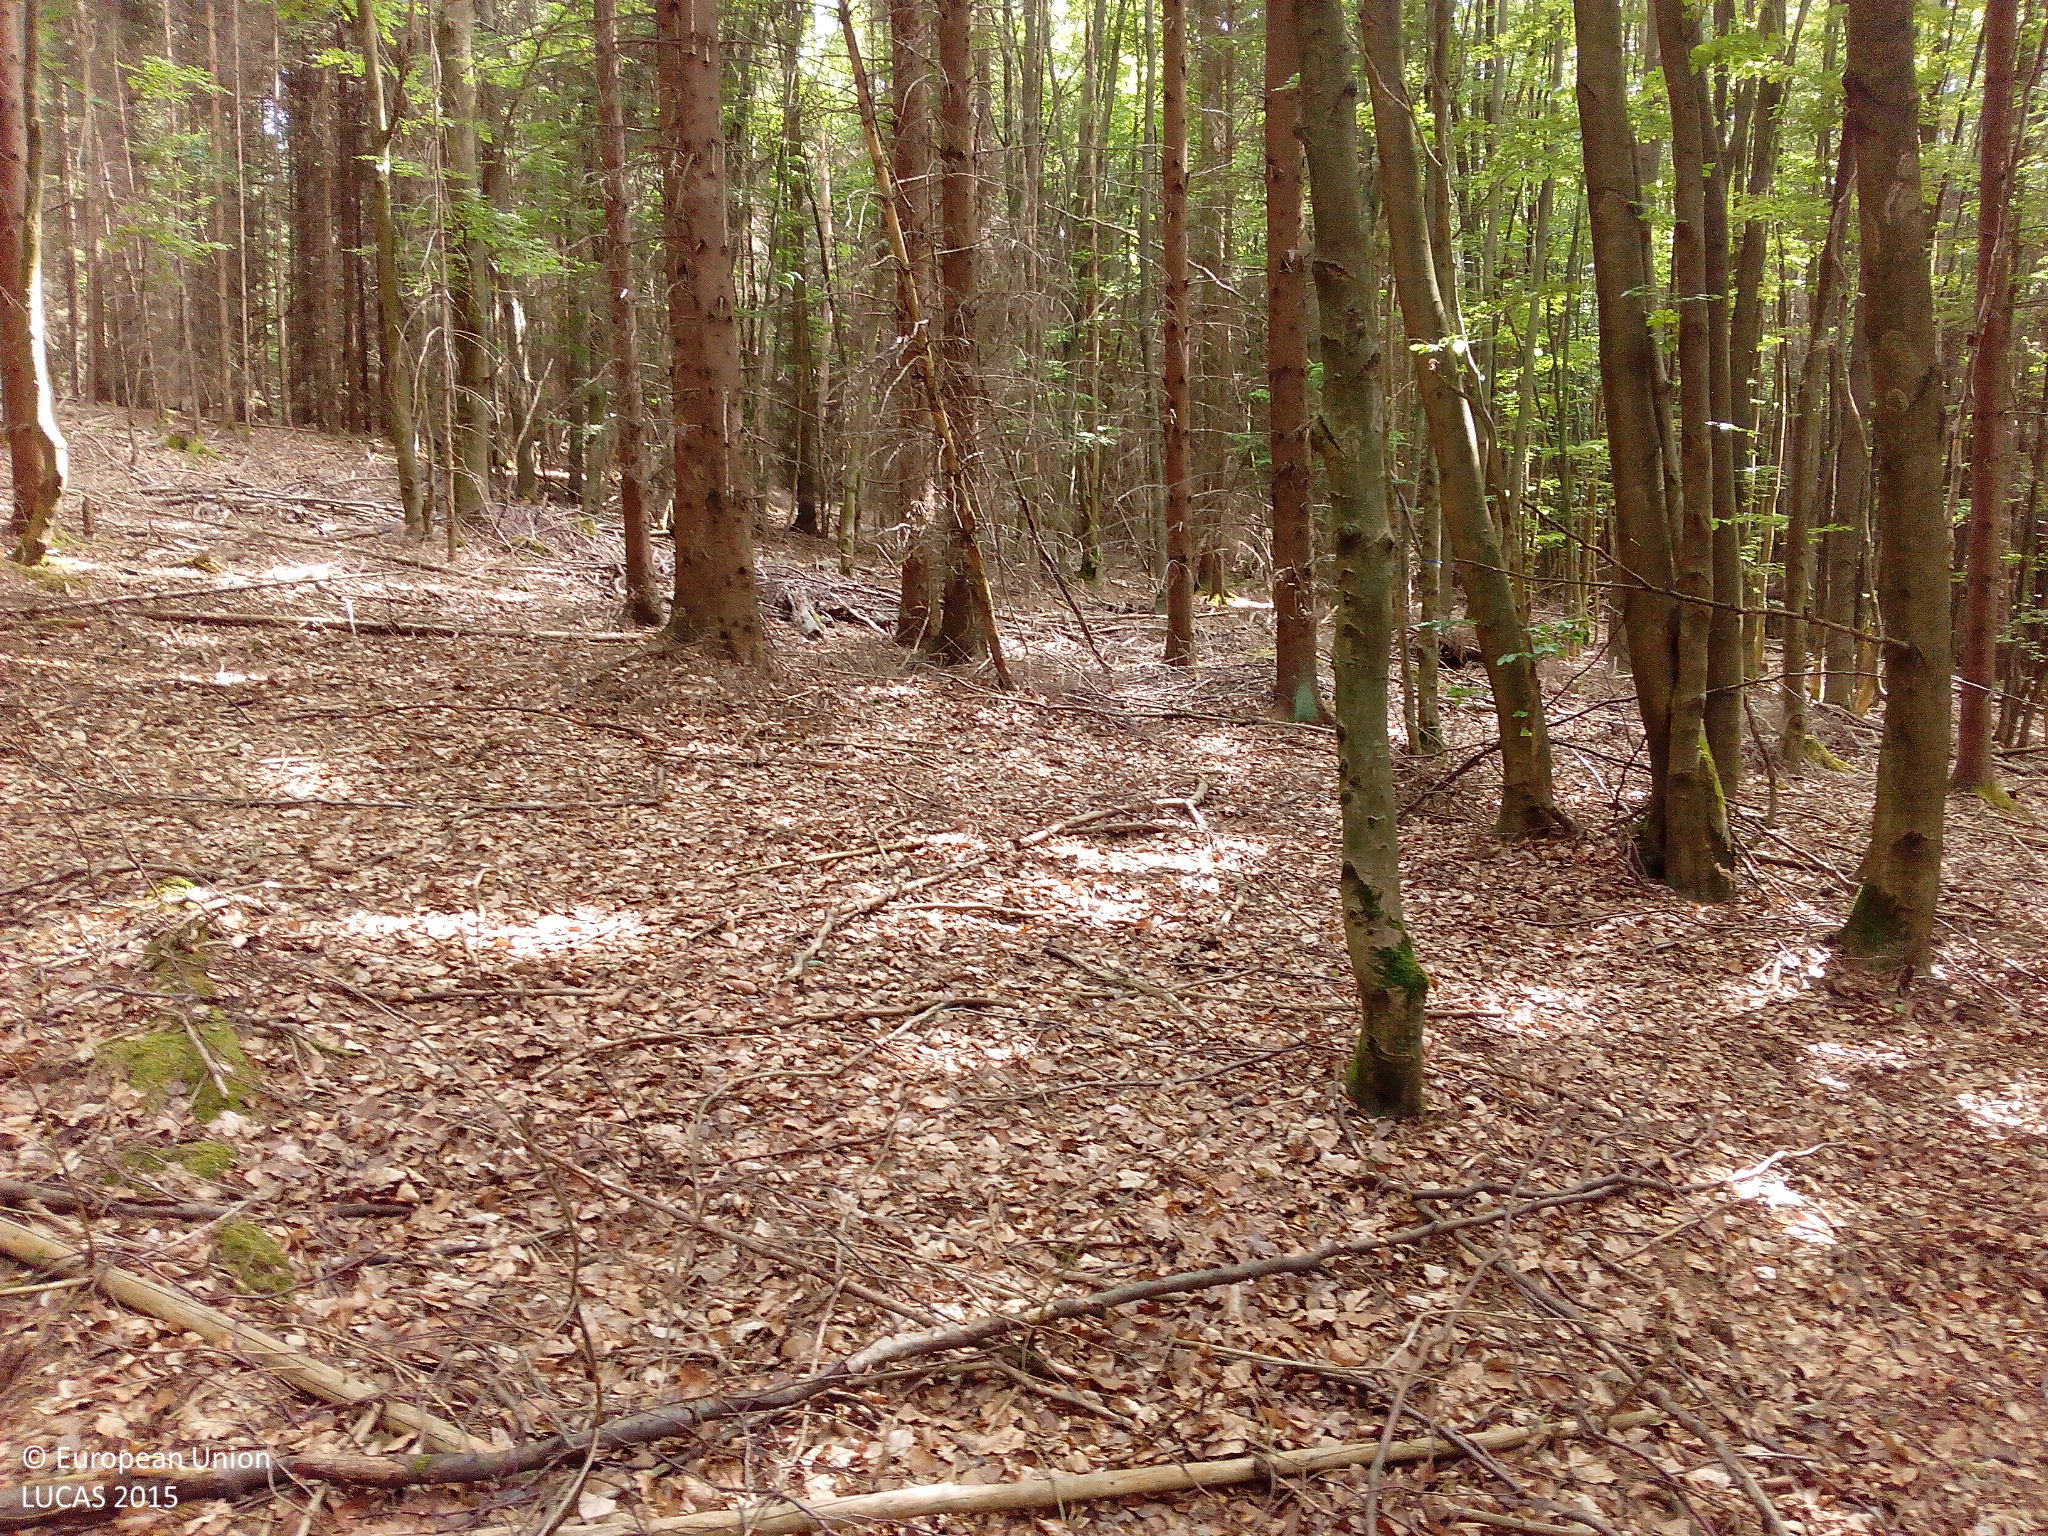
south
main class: Woodland
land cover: Spruce dominated mixed woodland
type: hemiboreal forest and nemoral coniferous forest and mixed broadleaved-coniferous forest
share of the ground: > 75 %
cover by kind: broadleaved forest trees 55 %, coniferous forest trees 45 %
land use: Forestry
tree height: > 5 m
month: June
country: DE
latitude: 50.9015
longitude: 9.3319
